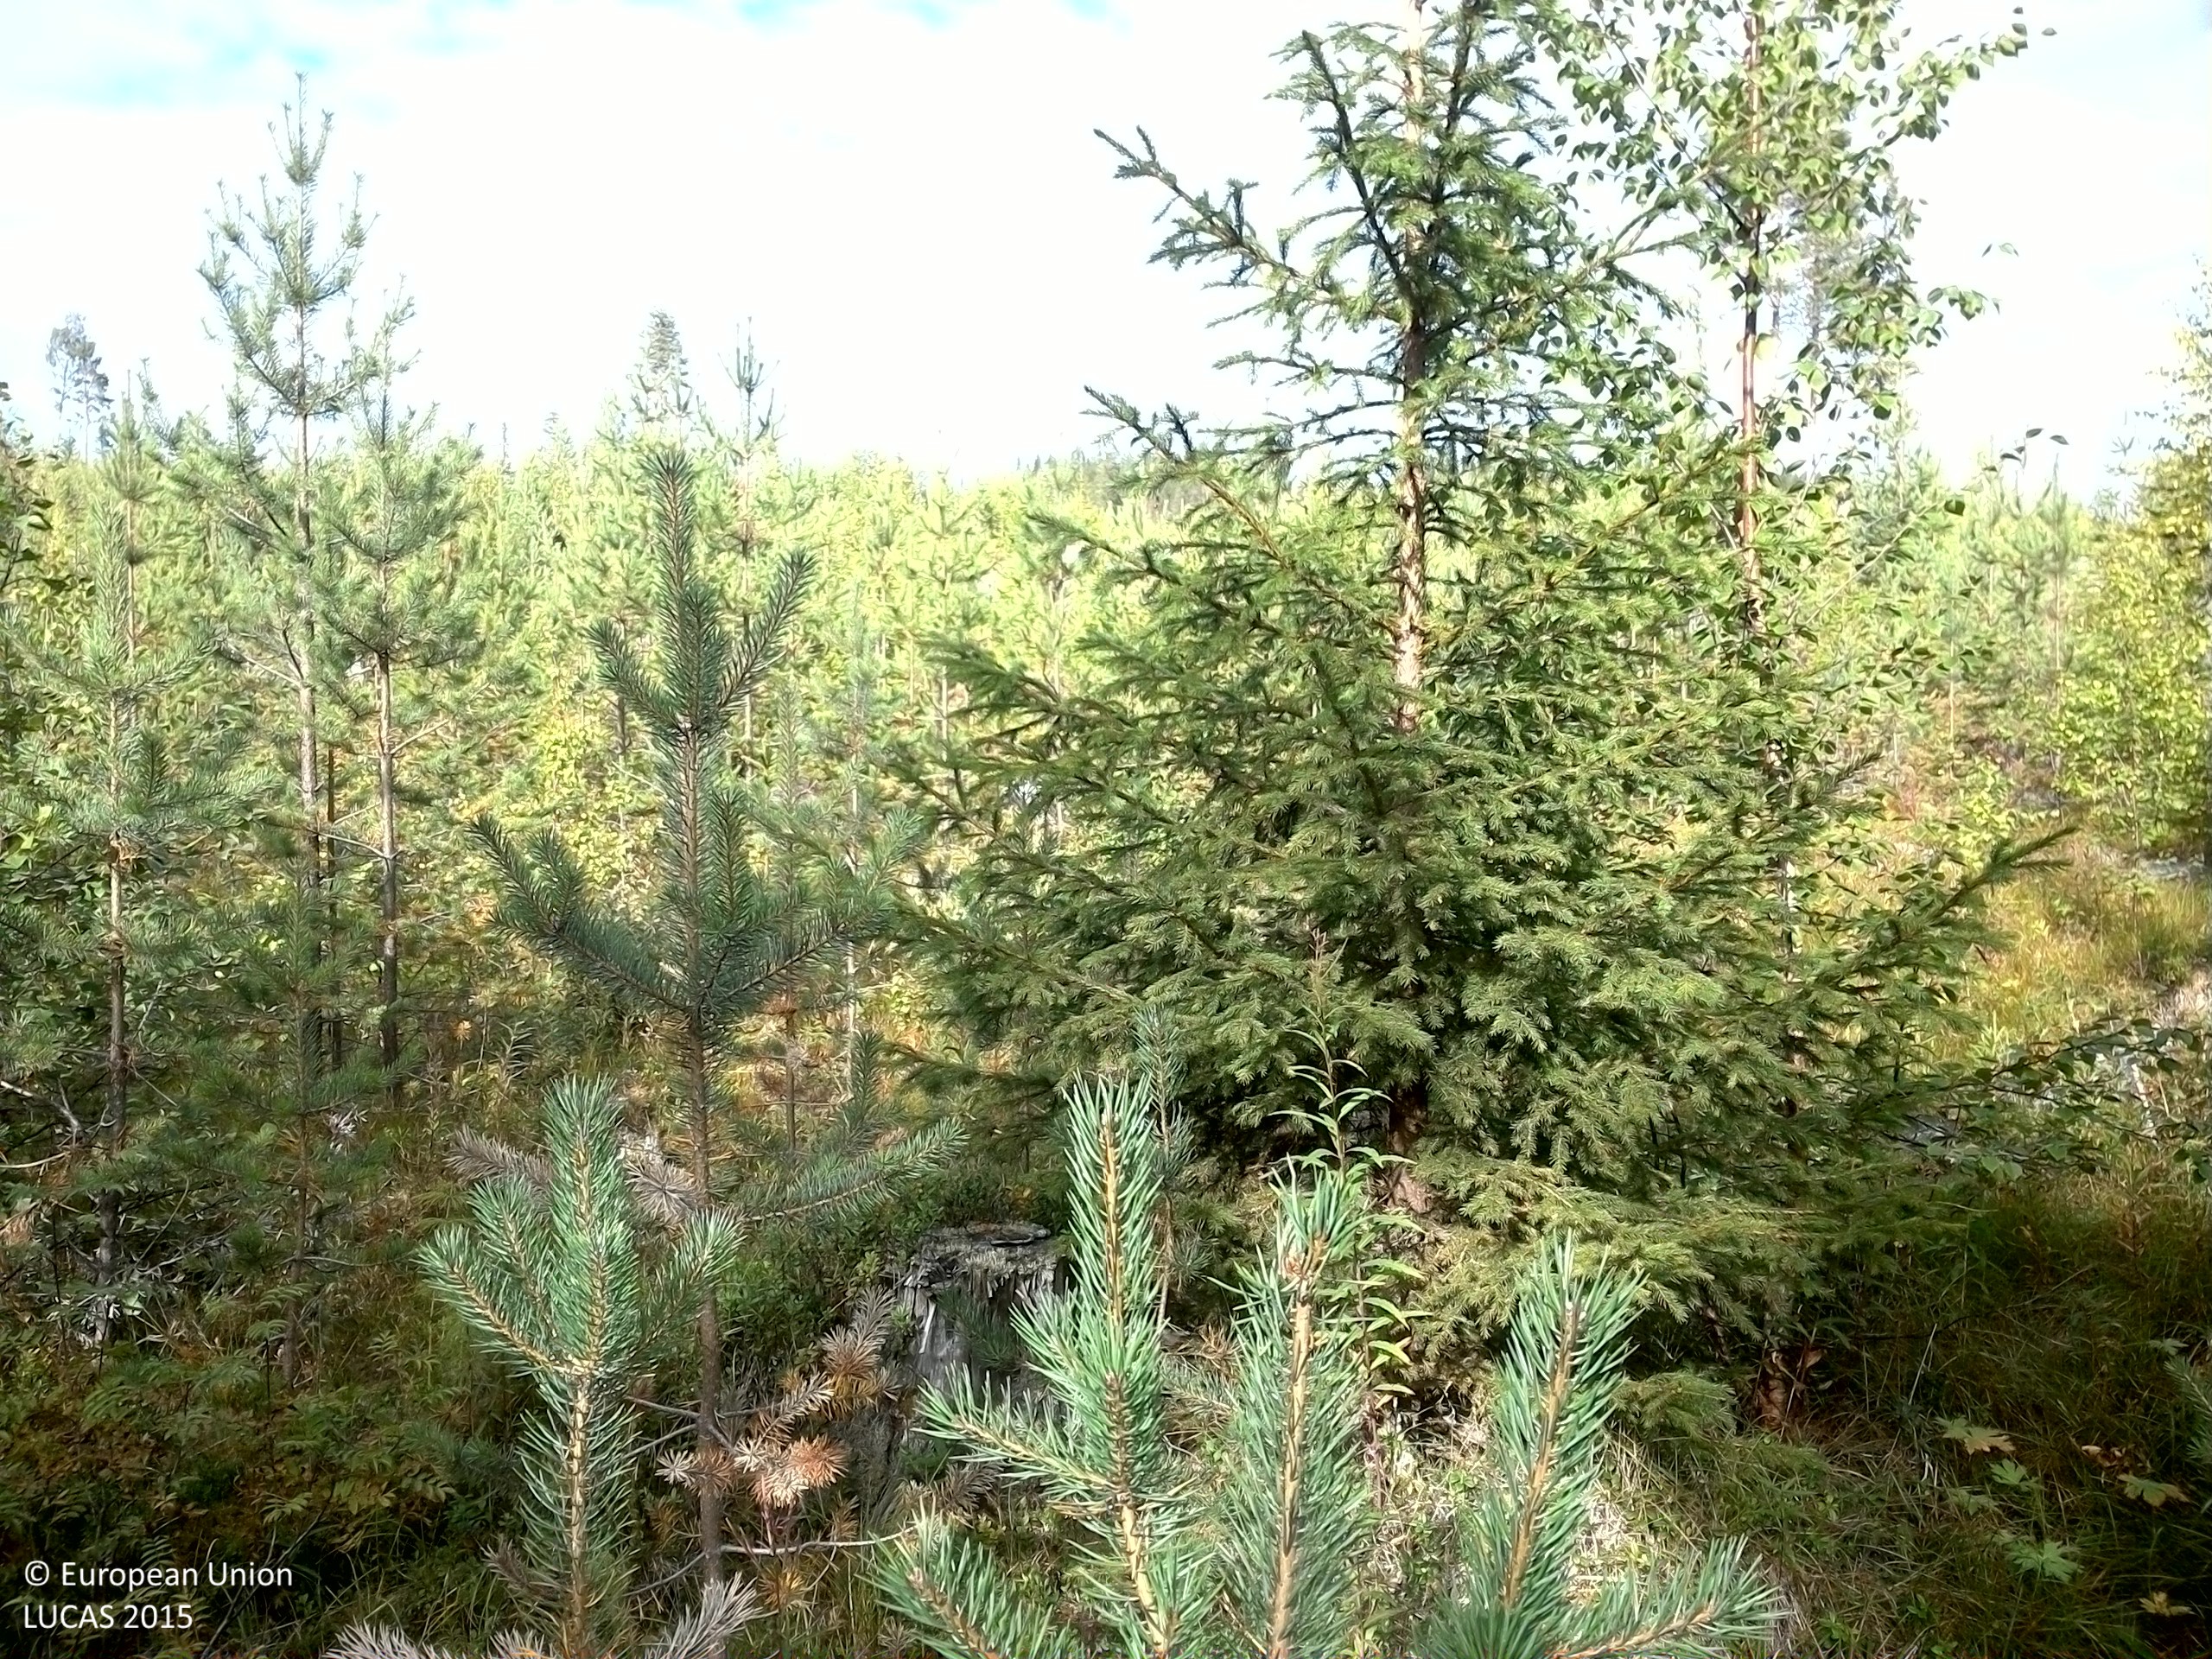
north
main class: Woodland
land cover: Pine dominated mixed woodland
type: boreal forest
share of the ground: 50 - 75 %
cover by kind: coniferous forest trees 35 %, broadleaved forest trees 35 %, shrubs 20 %, herbaceous plants 10 %
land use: Forestry
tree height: < 5 m
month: August
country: SE
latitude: 64.0476
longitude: 17.3228
